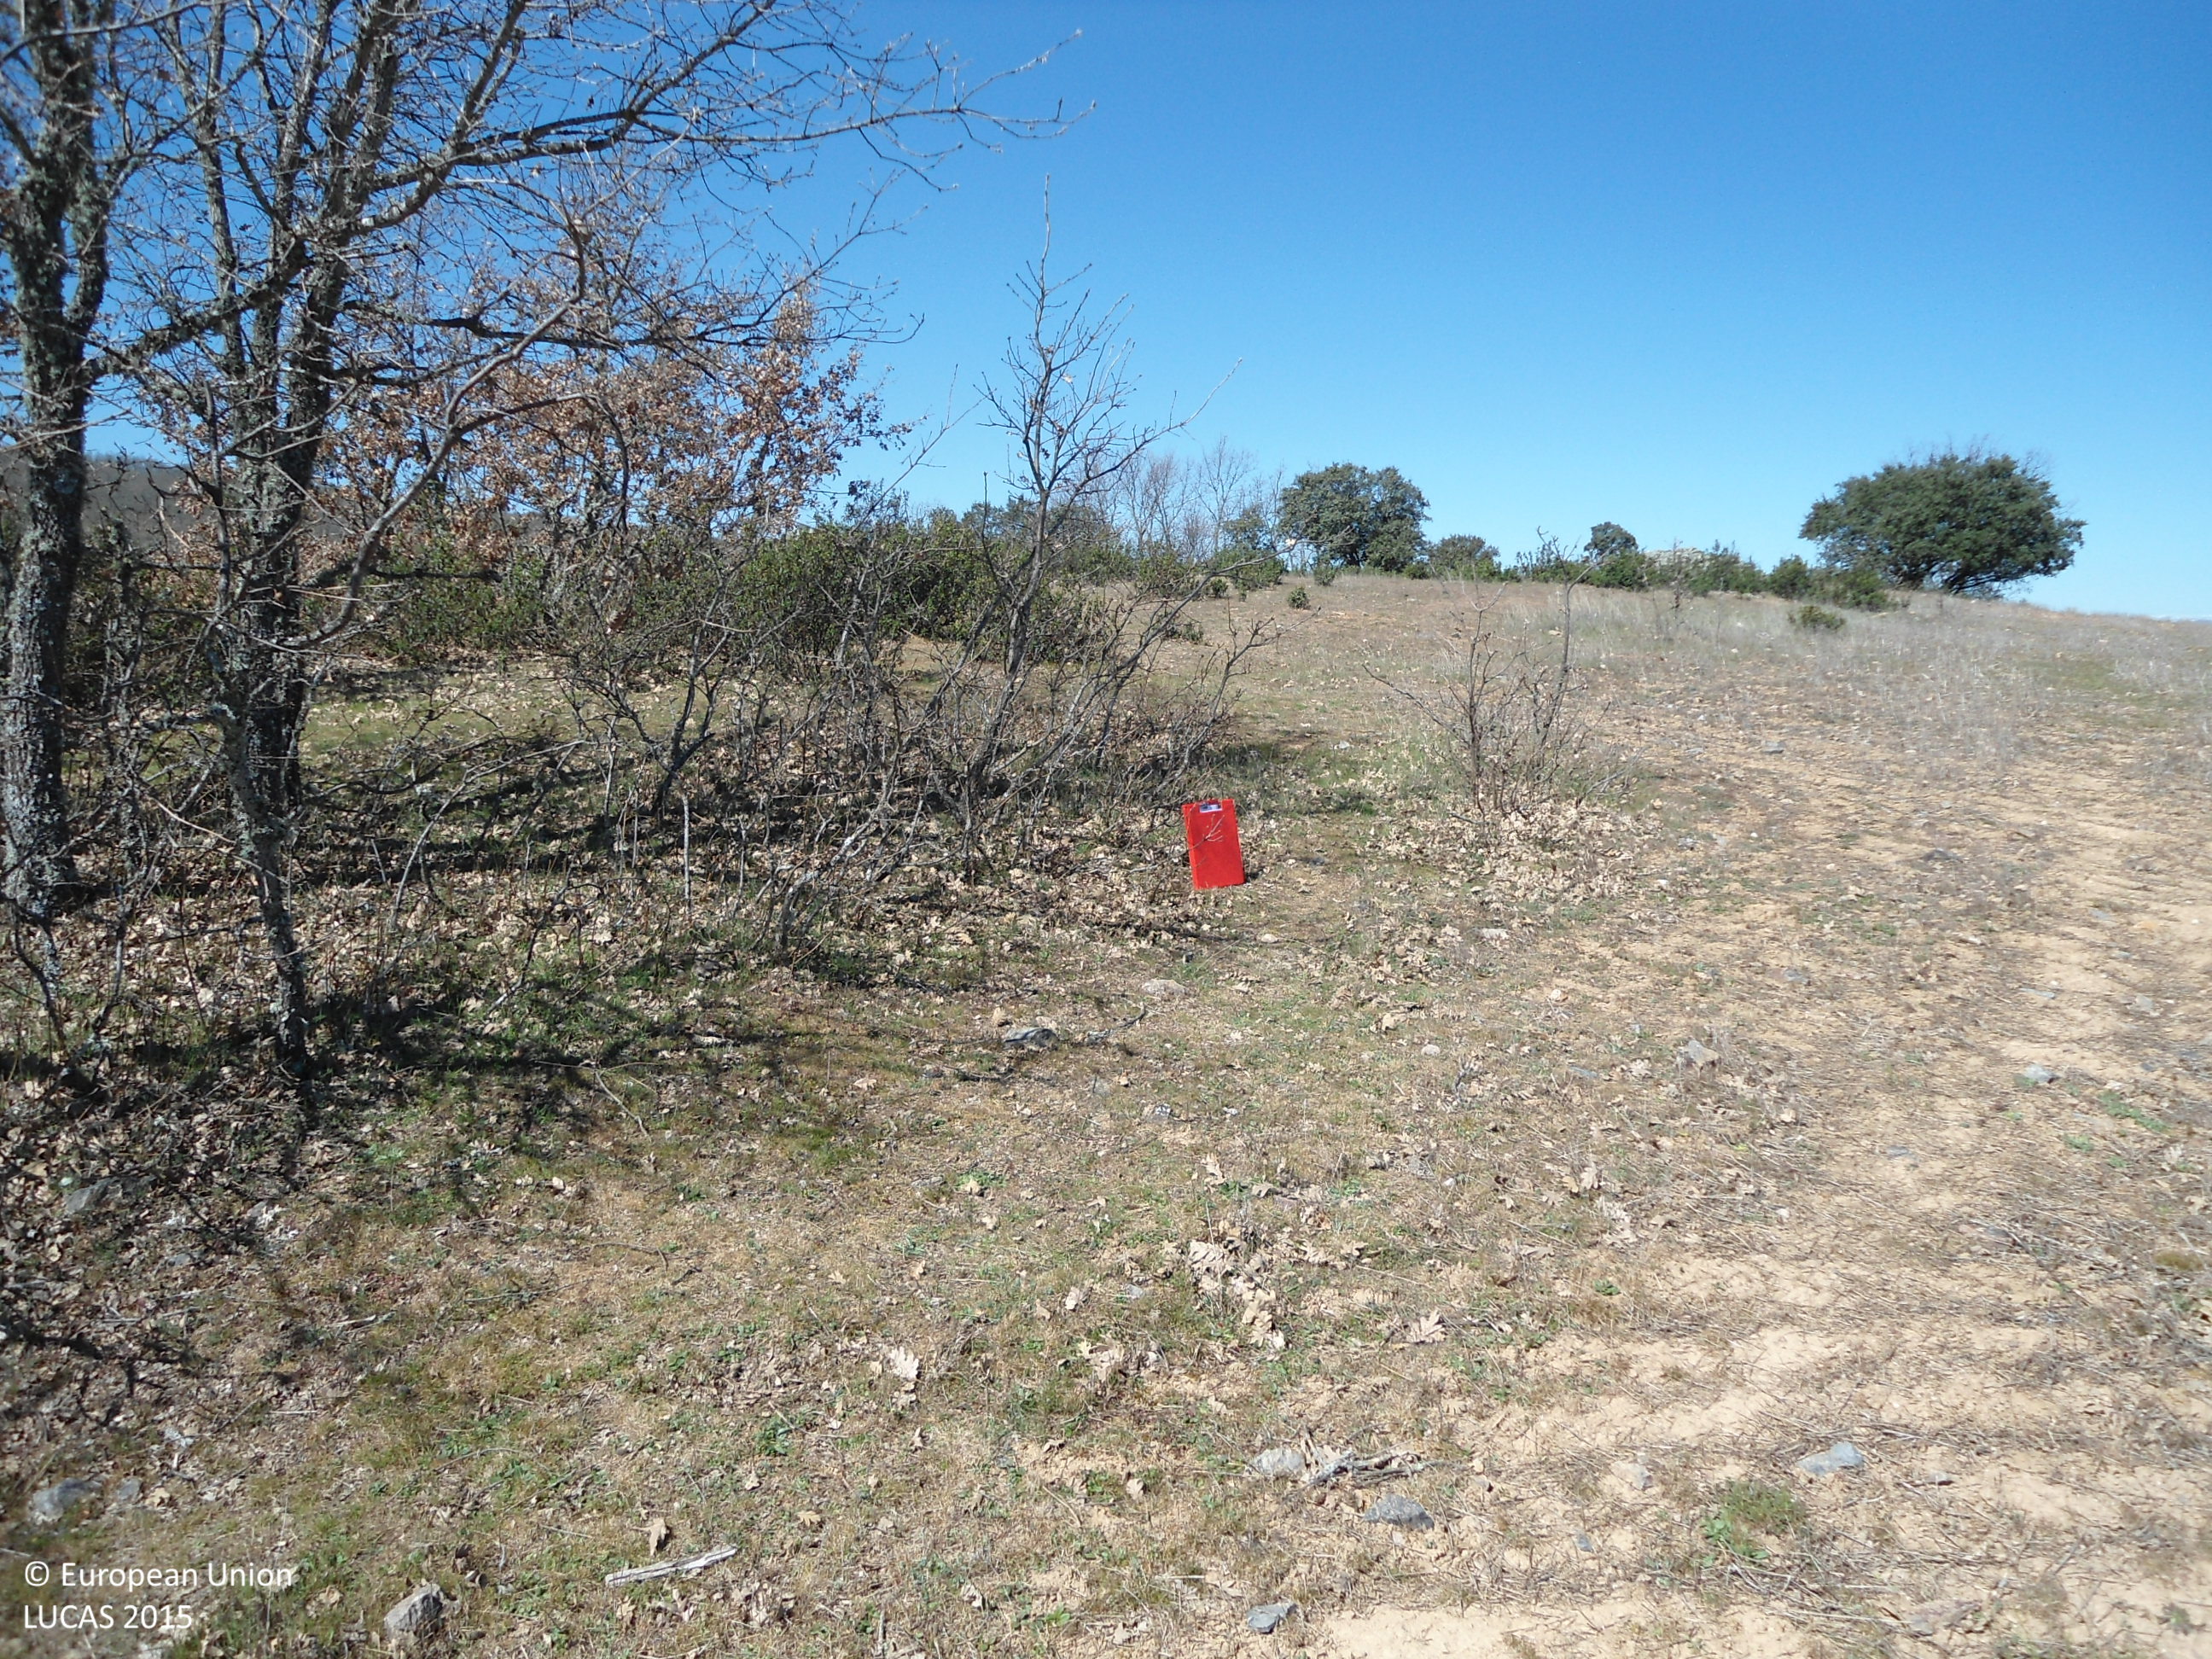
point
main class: Grassland
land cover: Spontaneously vegetated surfaces
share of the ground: 50 - 75 %
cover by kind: herbaceous plants 85 %, unconsolidated bare surface 10 %, shrubs 5 %
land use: Agriculture (excluding fallow land and kitchen gardens)
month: April
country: ES
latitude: 41.7364
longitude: -6.2477
